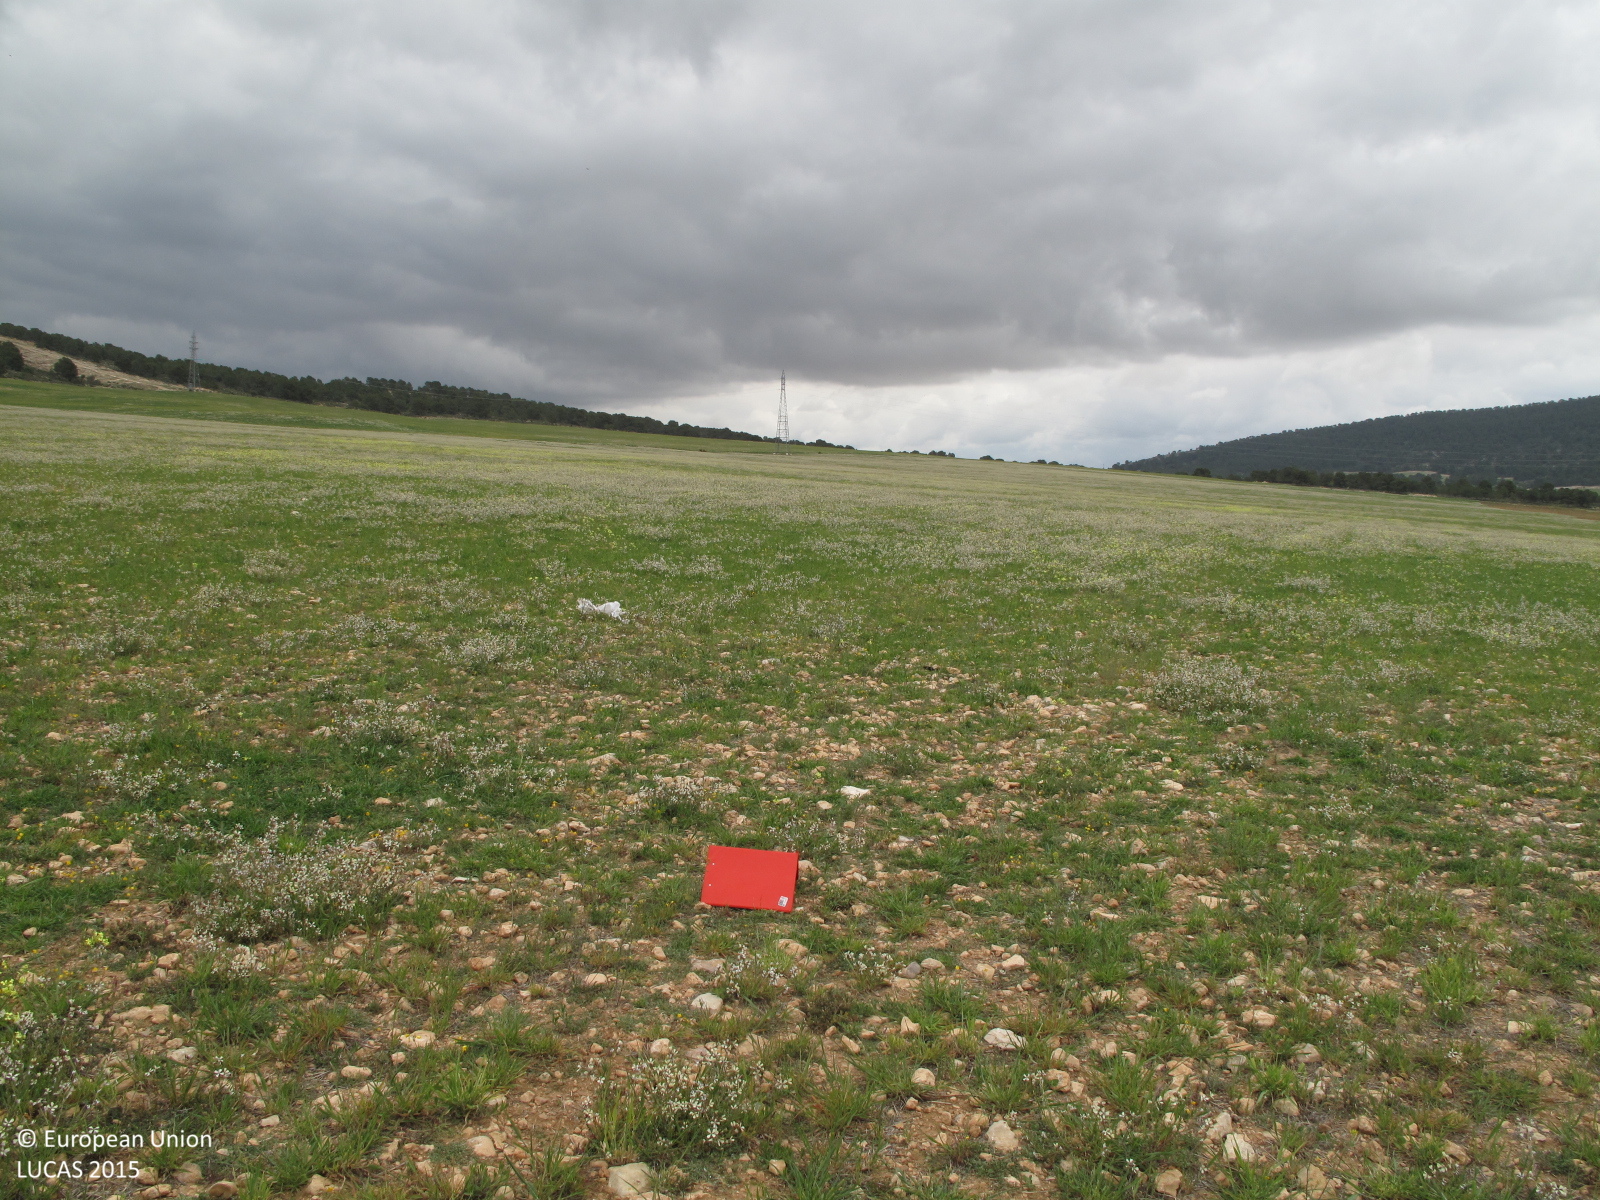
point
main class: Grassland
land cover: Spontaneously vegetated surfaces
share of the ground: > 75 %
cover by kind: herbaceous plants 90 %, unconsolidated bare surface 10 %
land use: Fallow land
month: April
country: ES
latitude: 38.7929
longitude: -0.9647
